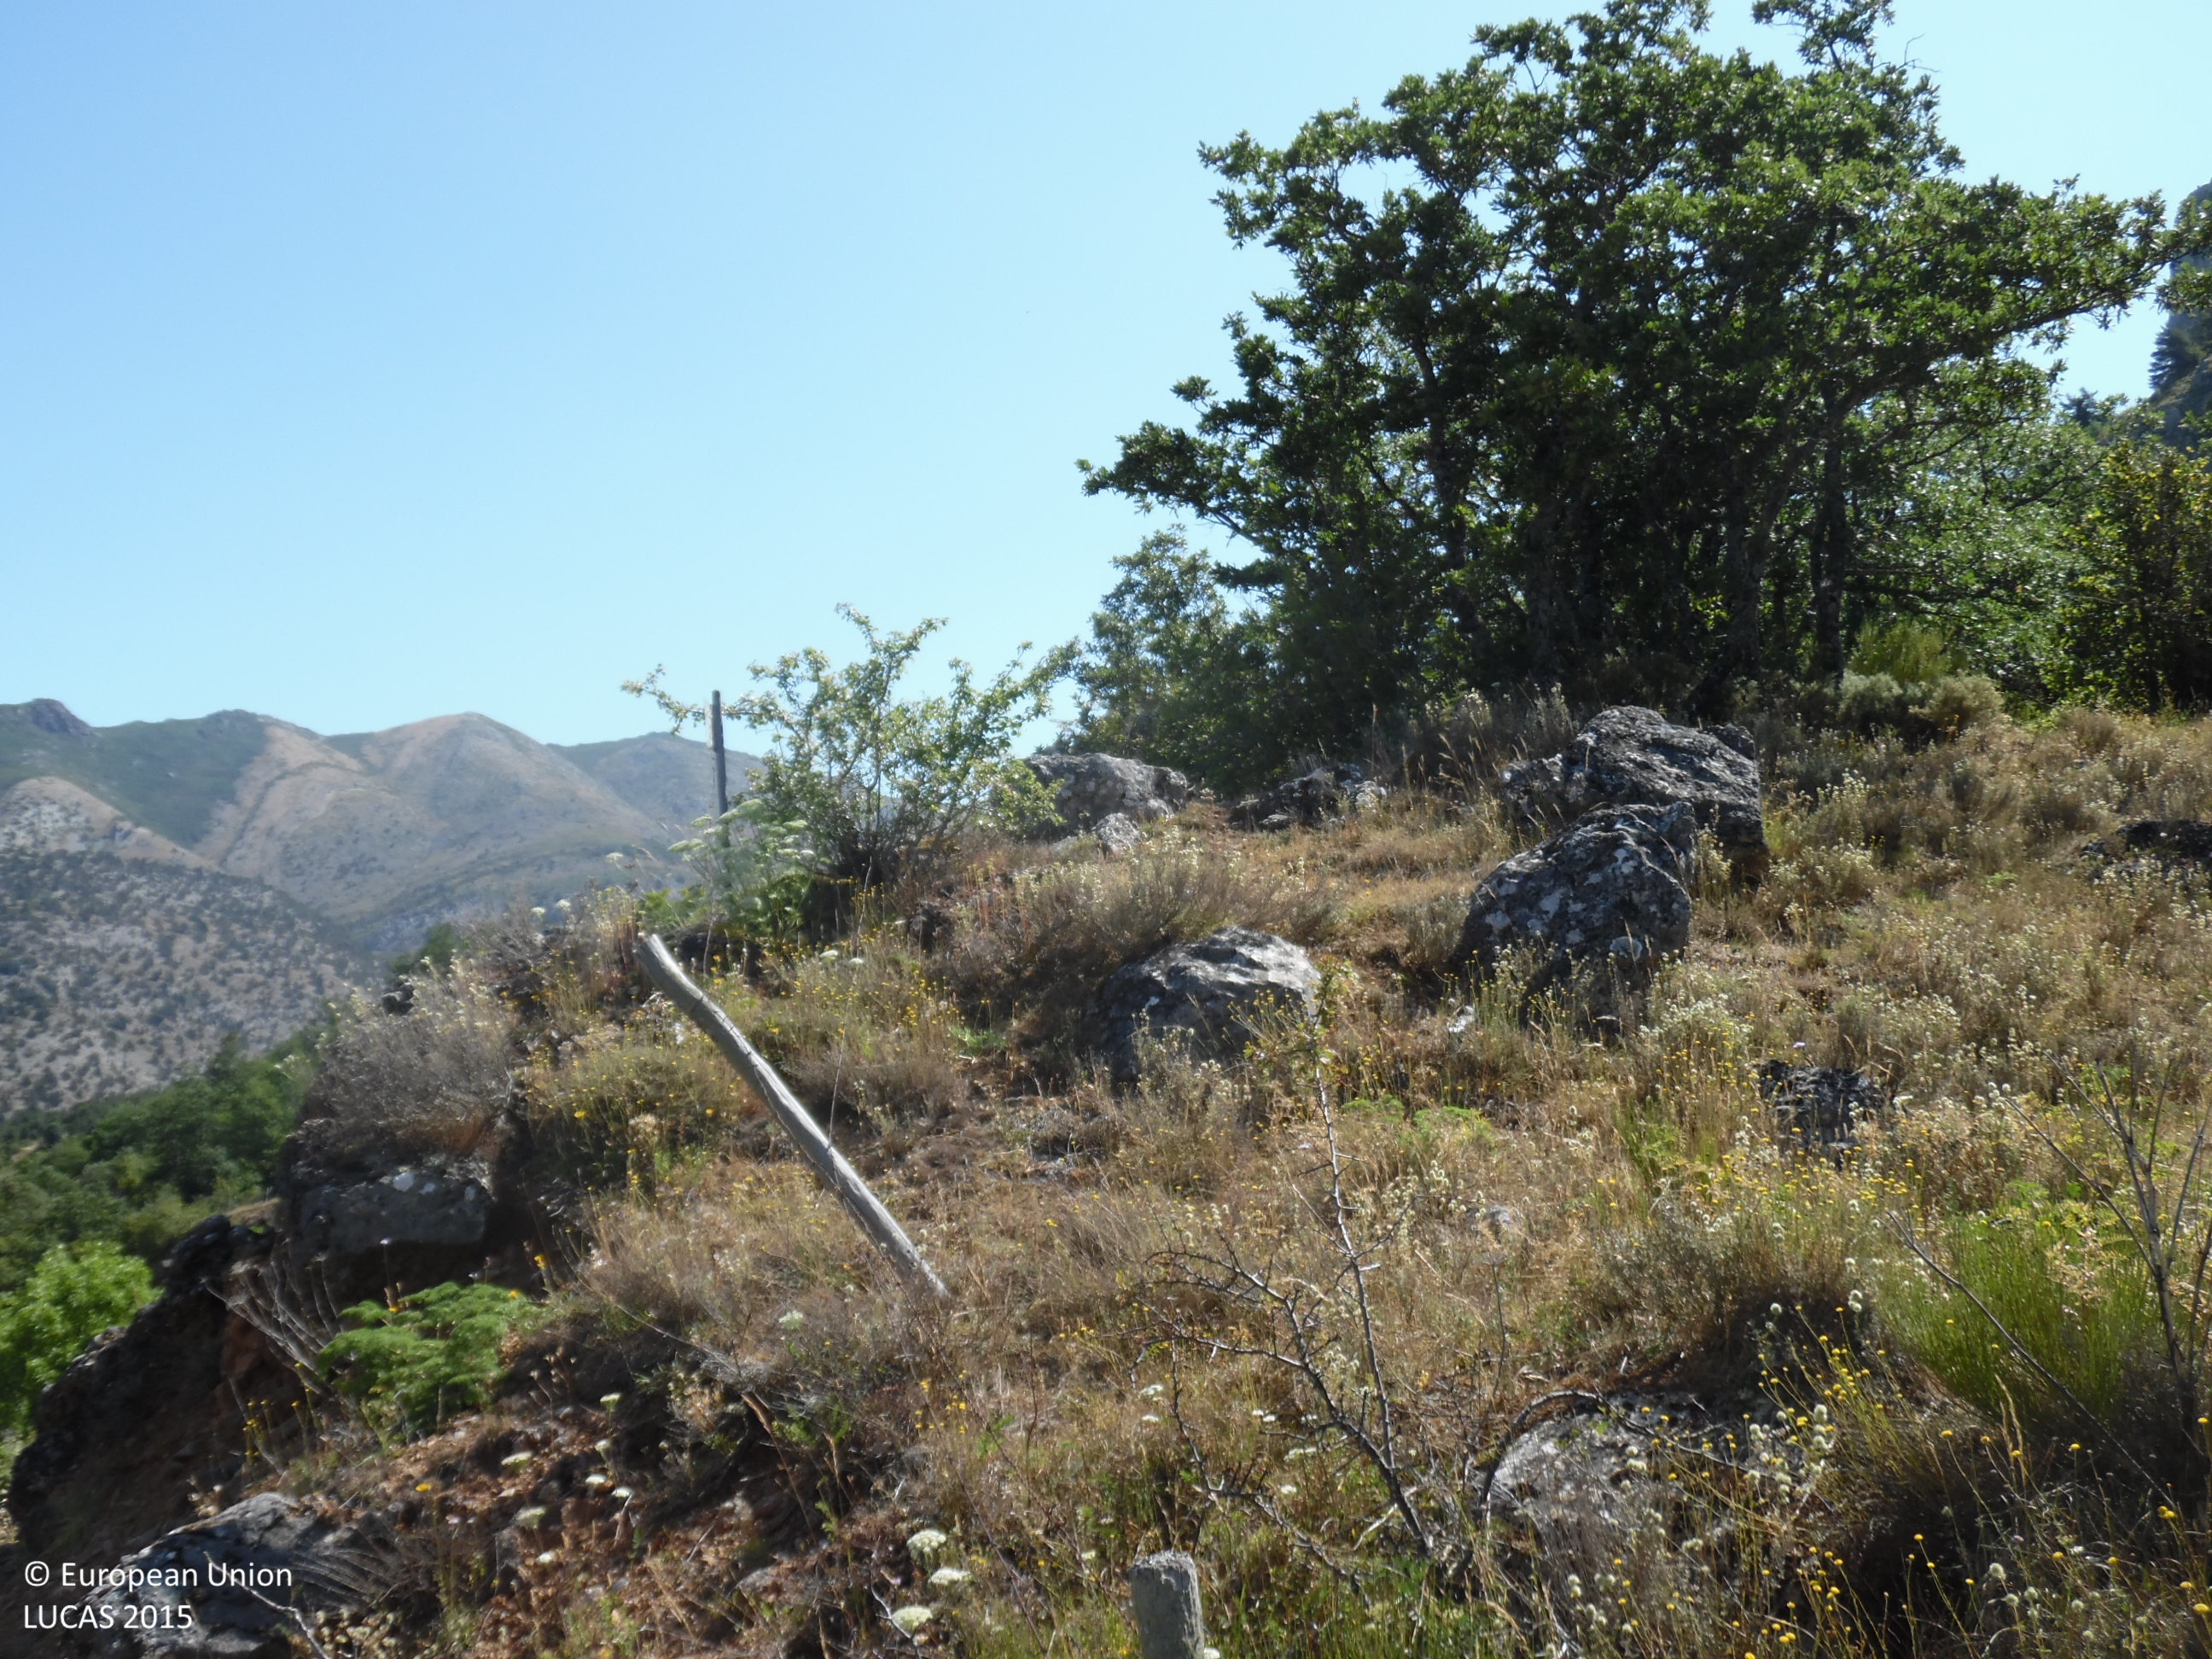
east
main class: Woodland
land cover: Broadleaved woodland
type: mountainous beech forest
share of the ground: > 75 %
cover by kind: broadleaved forest trees 90 %, shrubs 5 %, herbaceous plants 5 %
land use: Forestry
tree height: > 5 m
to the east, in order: Broadleaved woodland; Rocks and stones; Broadleaved woodland; Rocks and stones; Broadleaved woodland
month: July
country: ES
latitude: 42.8645
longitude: -5.8593
